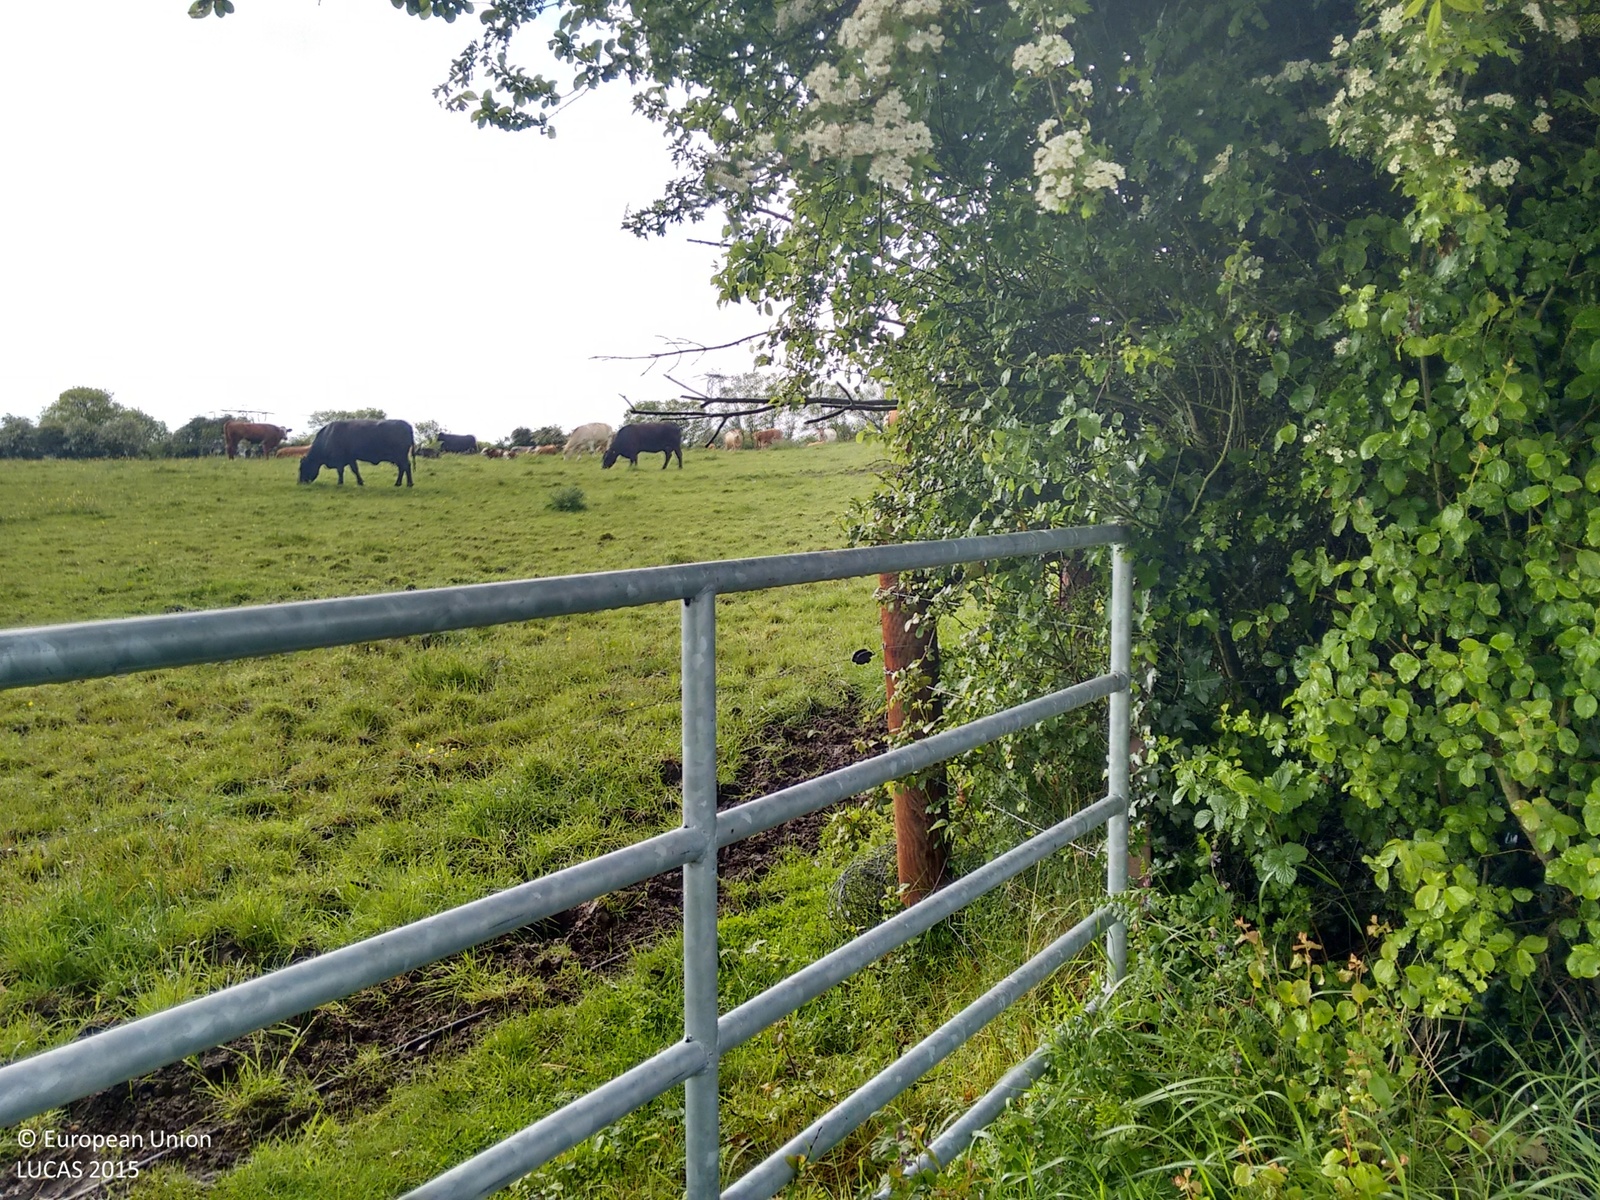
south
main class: Grassland
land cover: Grassland without tree/shrub cover
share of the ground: > 75 %
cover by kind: herbaceous plants 100 %
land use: Agriculture (excluding fallow land and kitchen gardens)
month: June
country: IE
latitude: 53.3961
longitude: -6.9073
